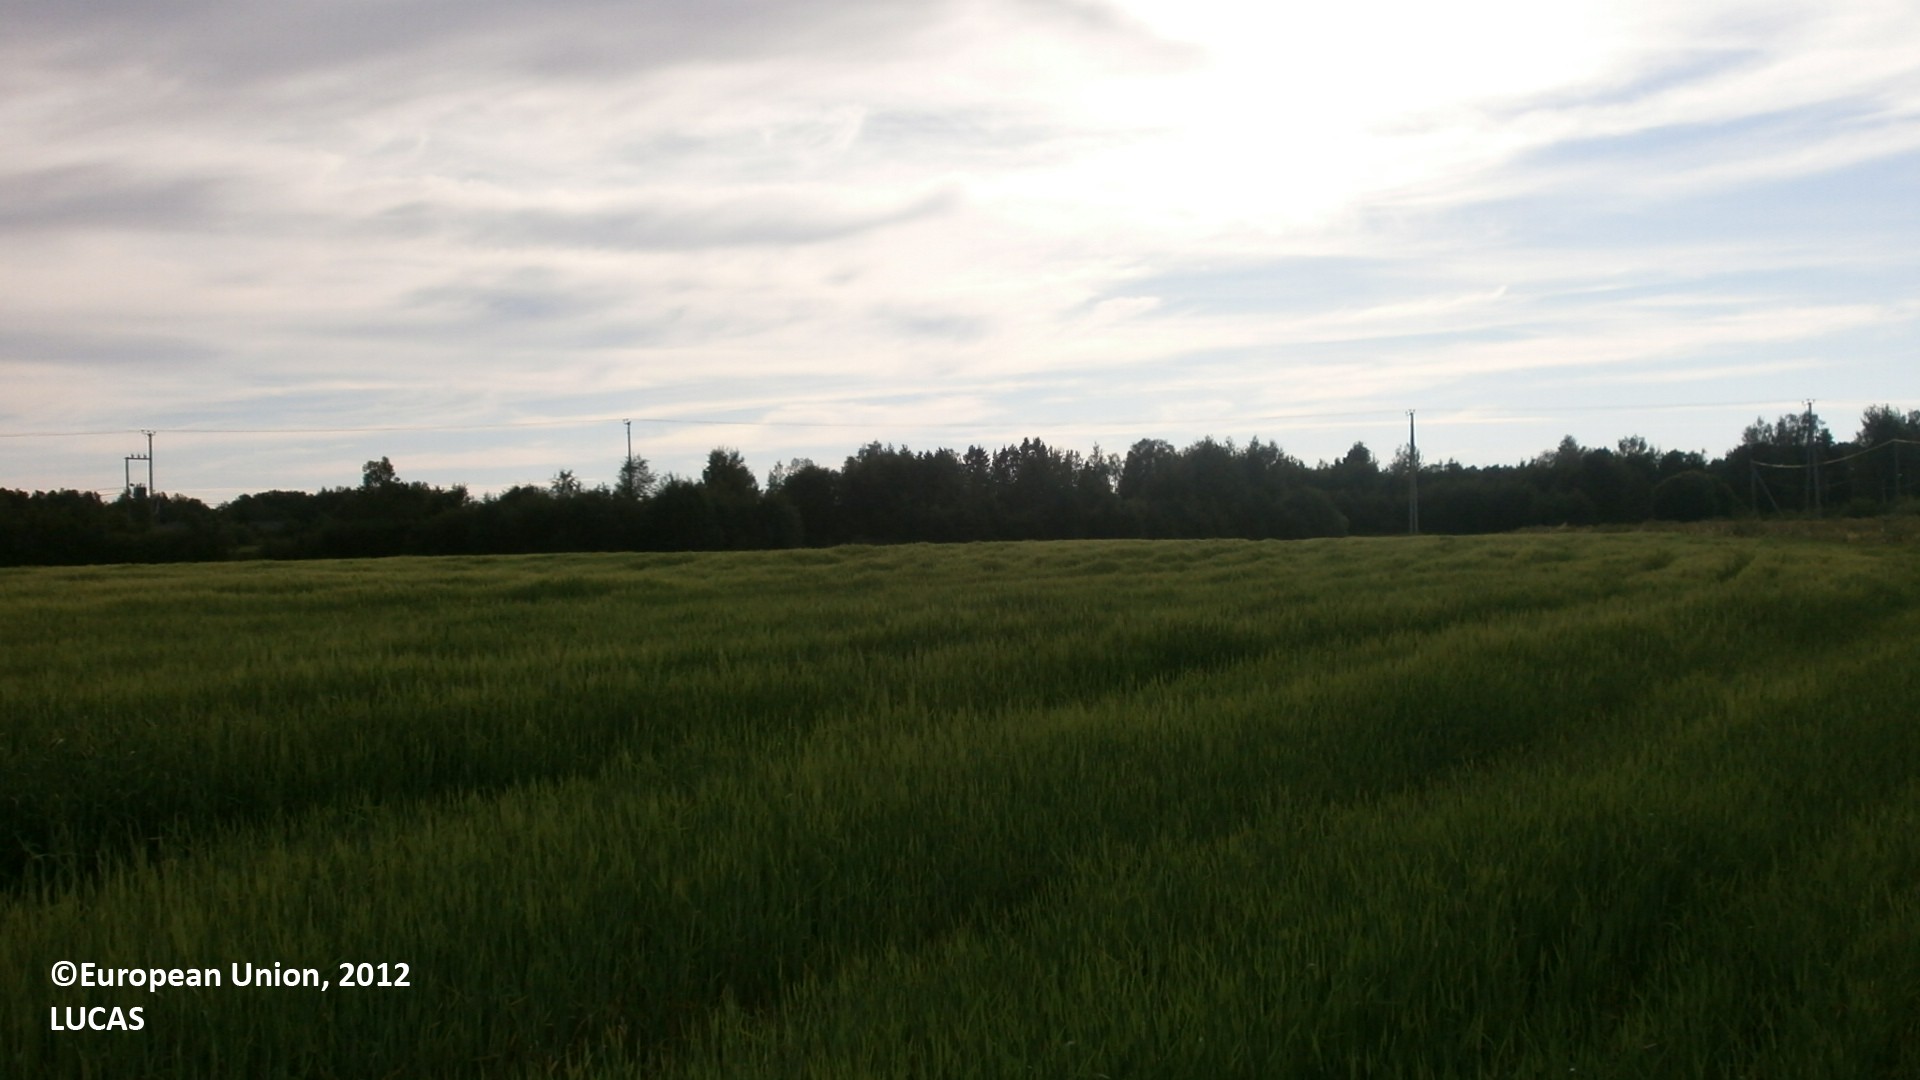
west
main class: Cropland
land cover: Barley
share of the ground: > 75 %
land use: Agriculture (excluding fallow land and kitchen gardens)
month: July
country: FI
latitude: 64.4073
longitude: 24.3209
